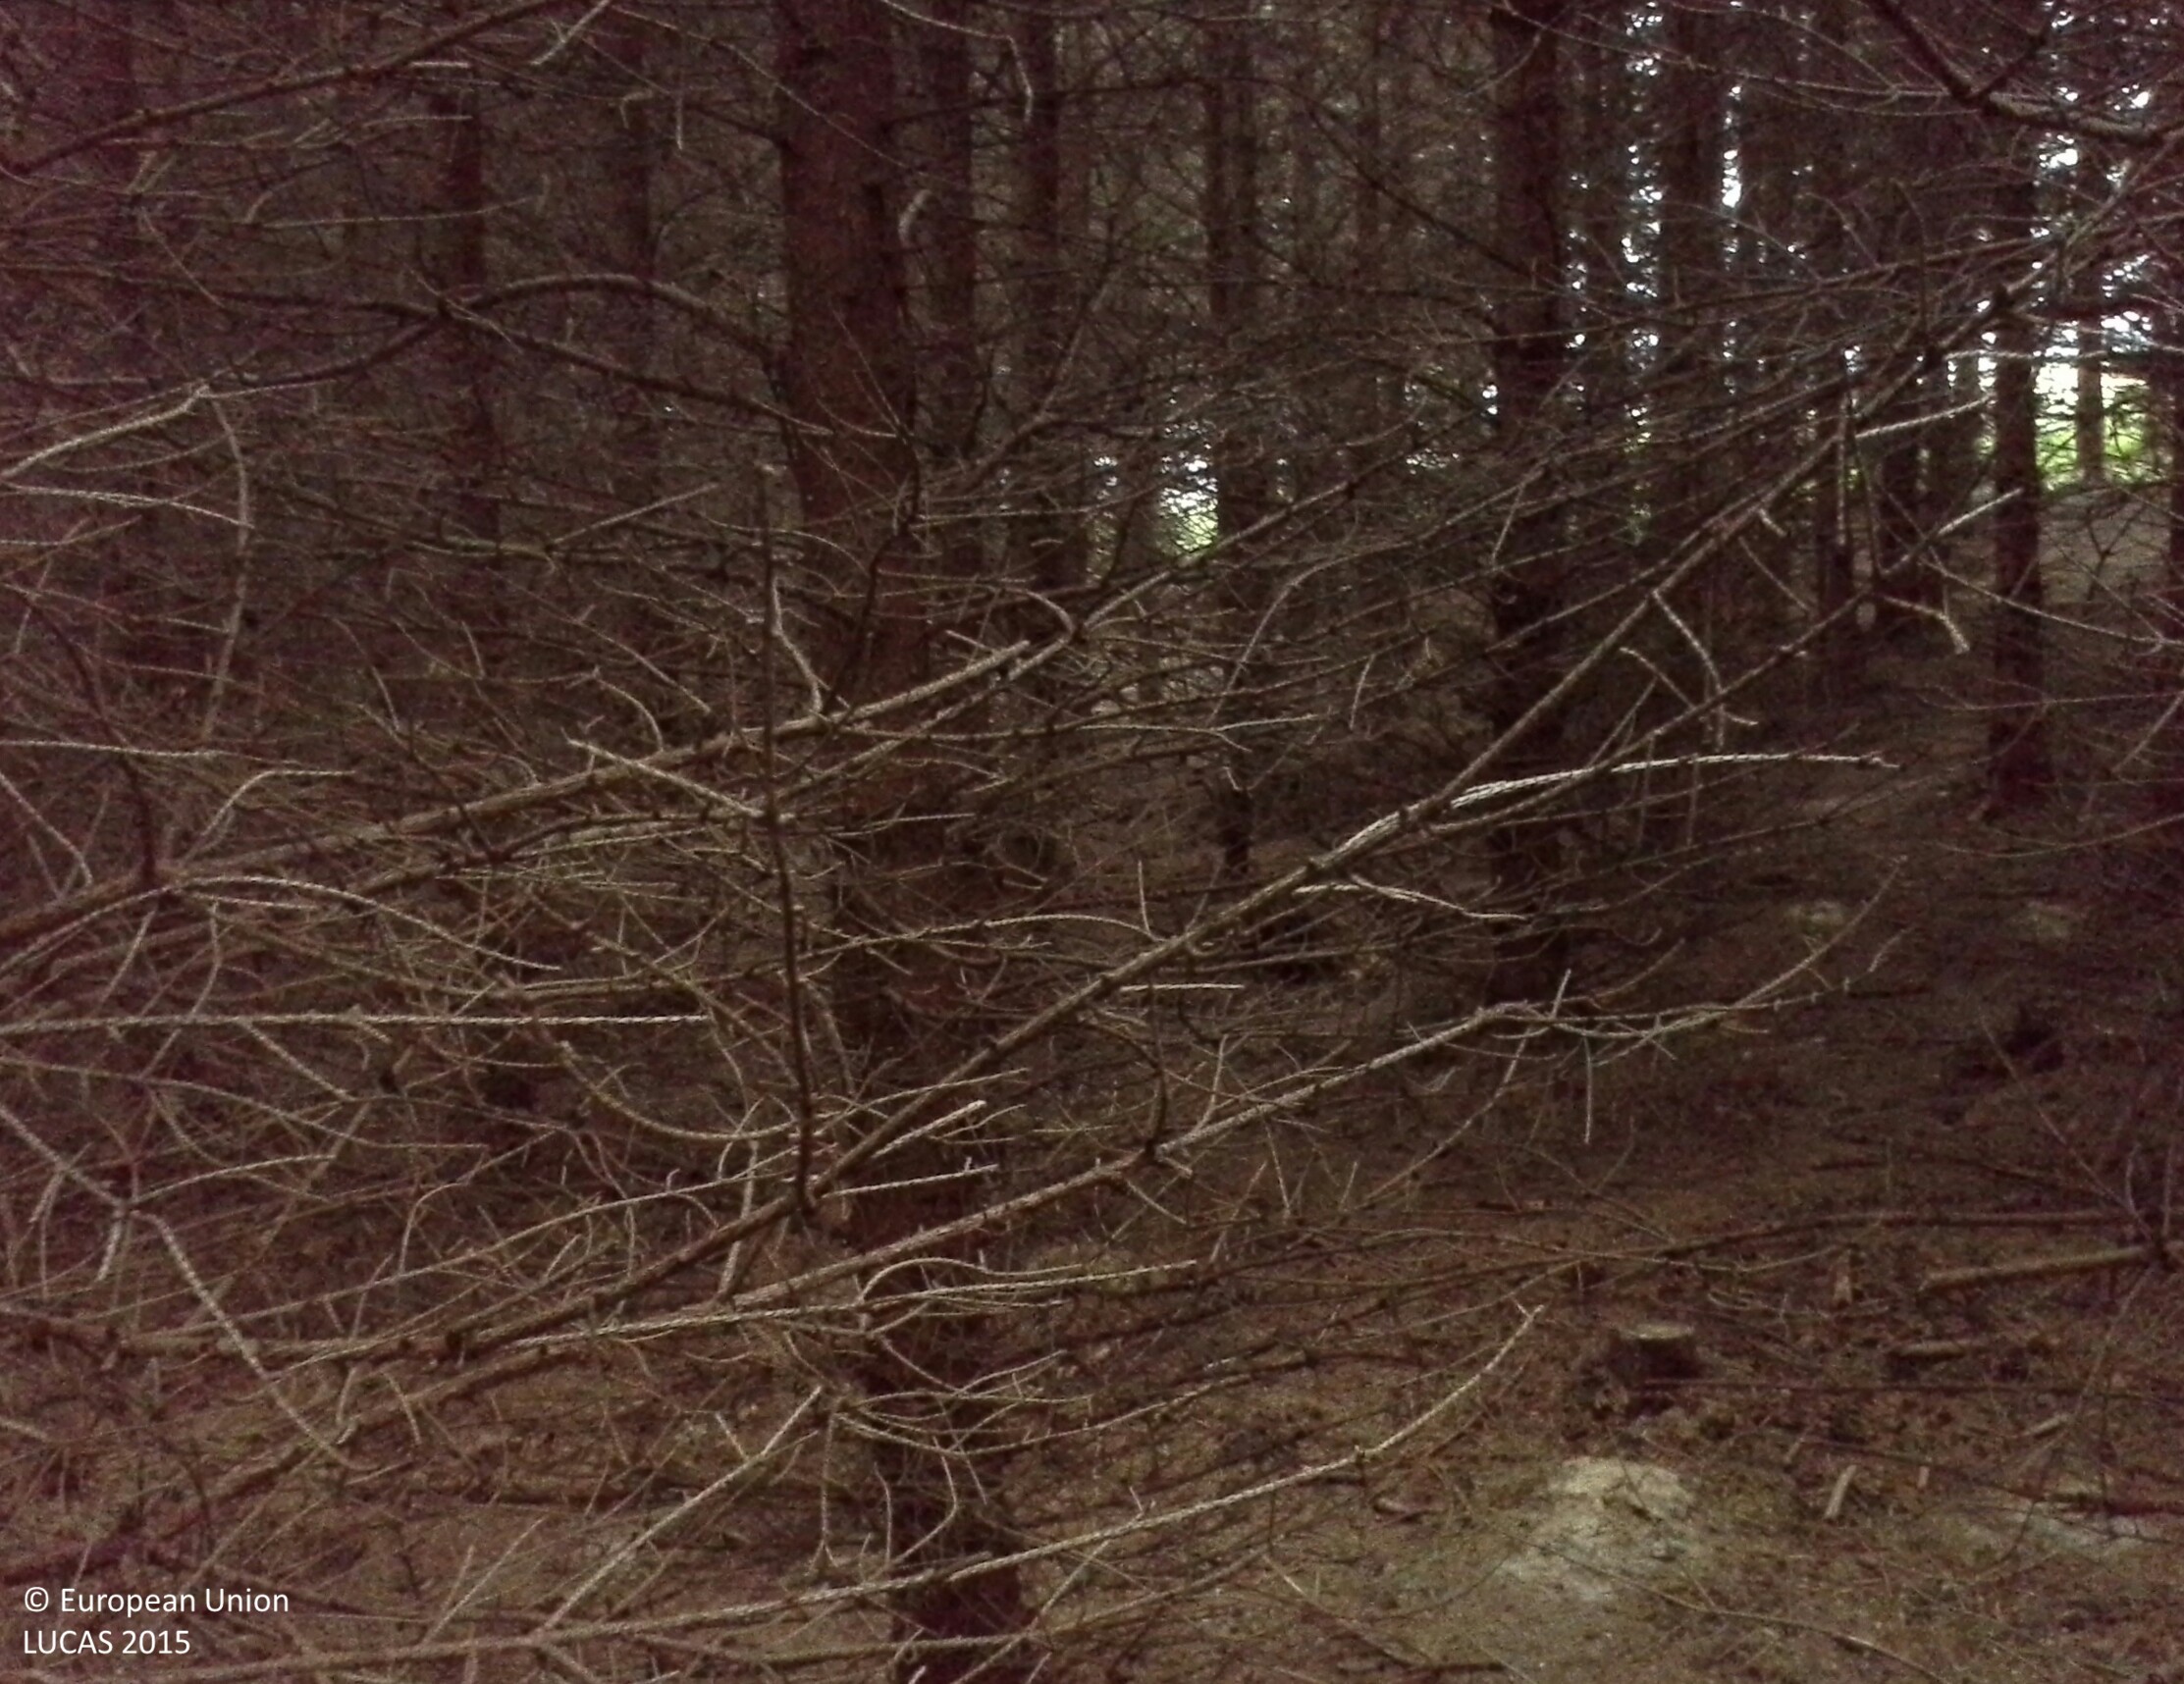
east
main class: Woodland
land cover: Spruce dominated coniferous woodland
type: hemiboreal forest and nemoral coniferous forest and mixed broadleaved-coniferous forest
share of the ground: > 75 %
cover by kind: coniferous forest trees 100 %
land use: Forestry
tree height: > 5 m
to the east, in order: Spruce dominated coniferous woodland; Shrubland without tree cover; Grassland without tree/shrub cover; Tracks; Grassland without tree/shrub cover; Electric lines; Grassland without tree/shrub cover
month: July
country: AT
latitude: 48.0149
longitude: 14.7060
